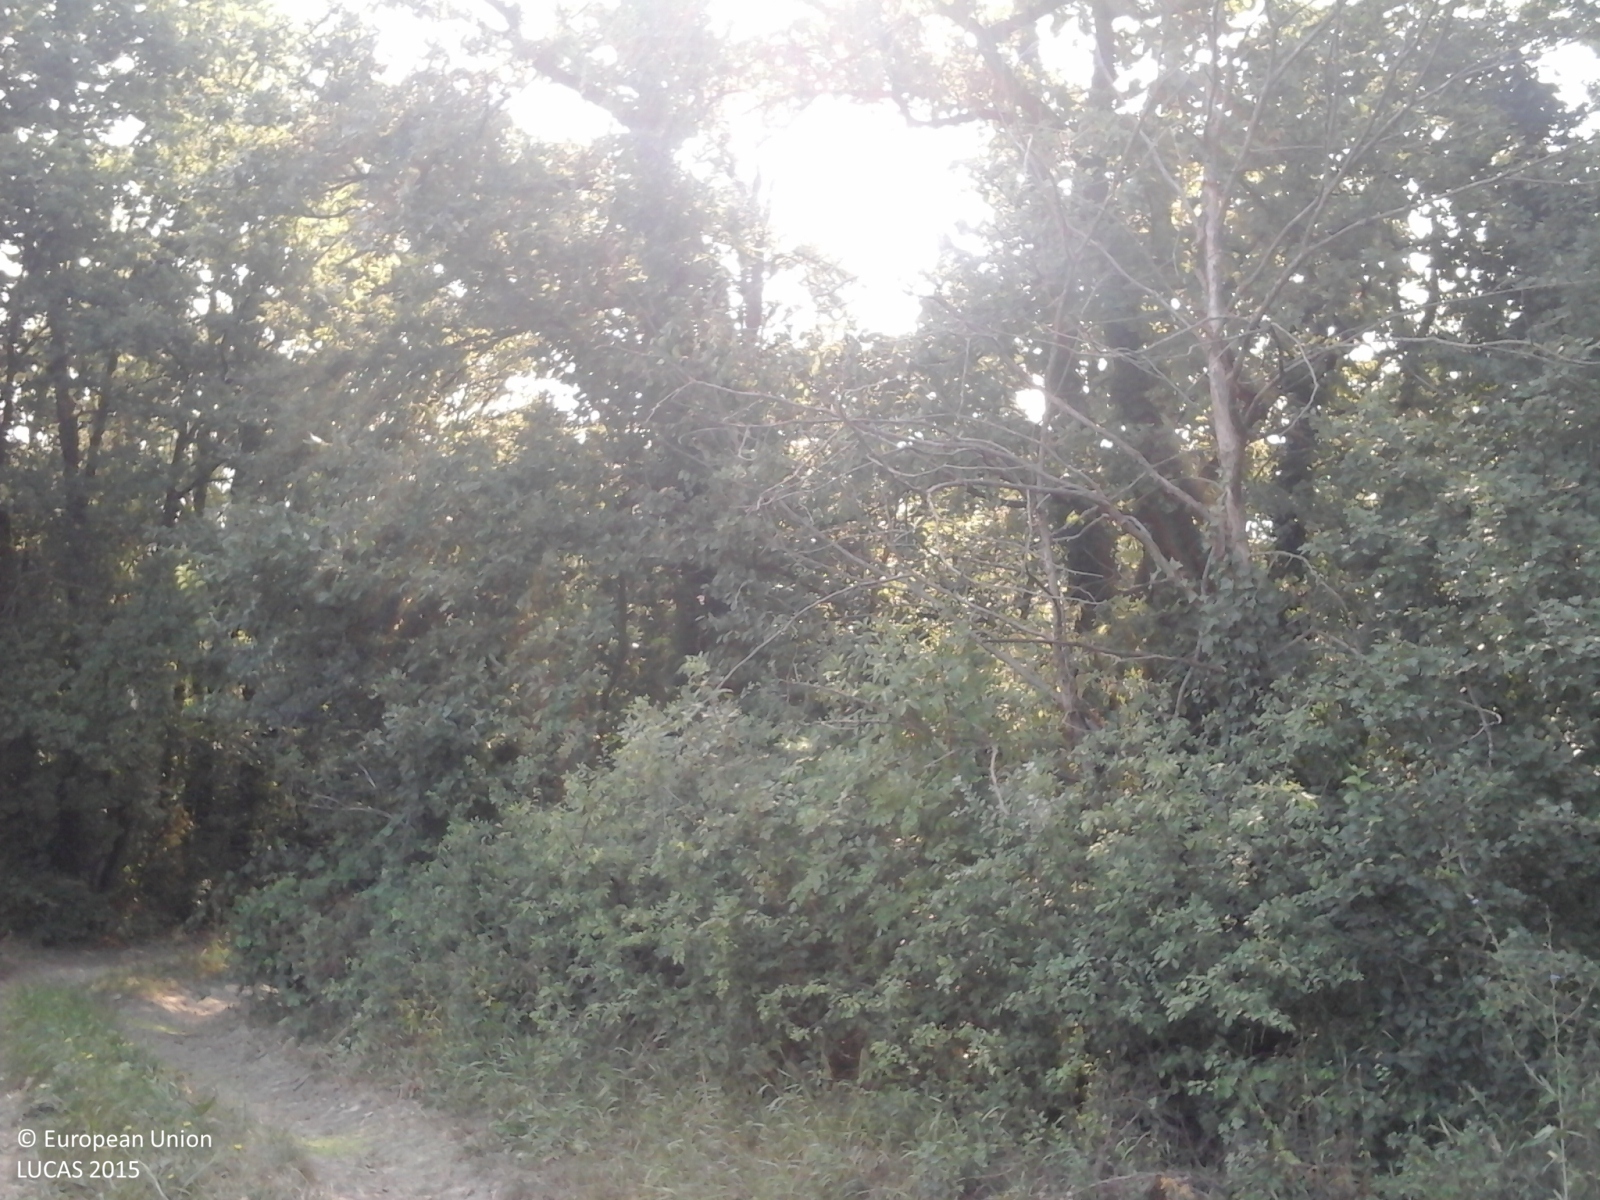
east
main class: Cropland
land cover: Maize
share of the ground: > 75 %
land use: Agriculture (excluding fallow land and kitchen gardens)
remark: Harvested field
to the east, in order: Tracks; Broadleaved woodland; Spontaneously vegetated surfaces
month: July
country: IT
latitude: 44.3648
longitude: 10.8889
